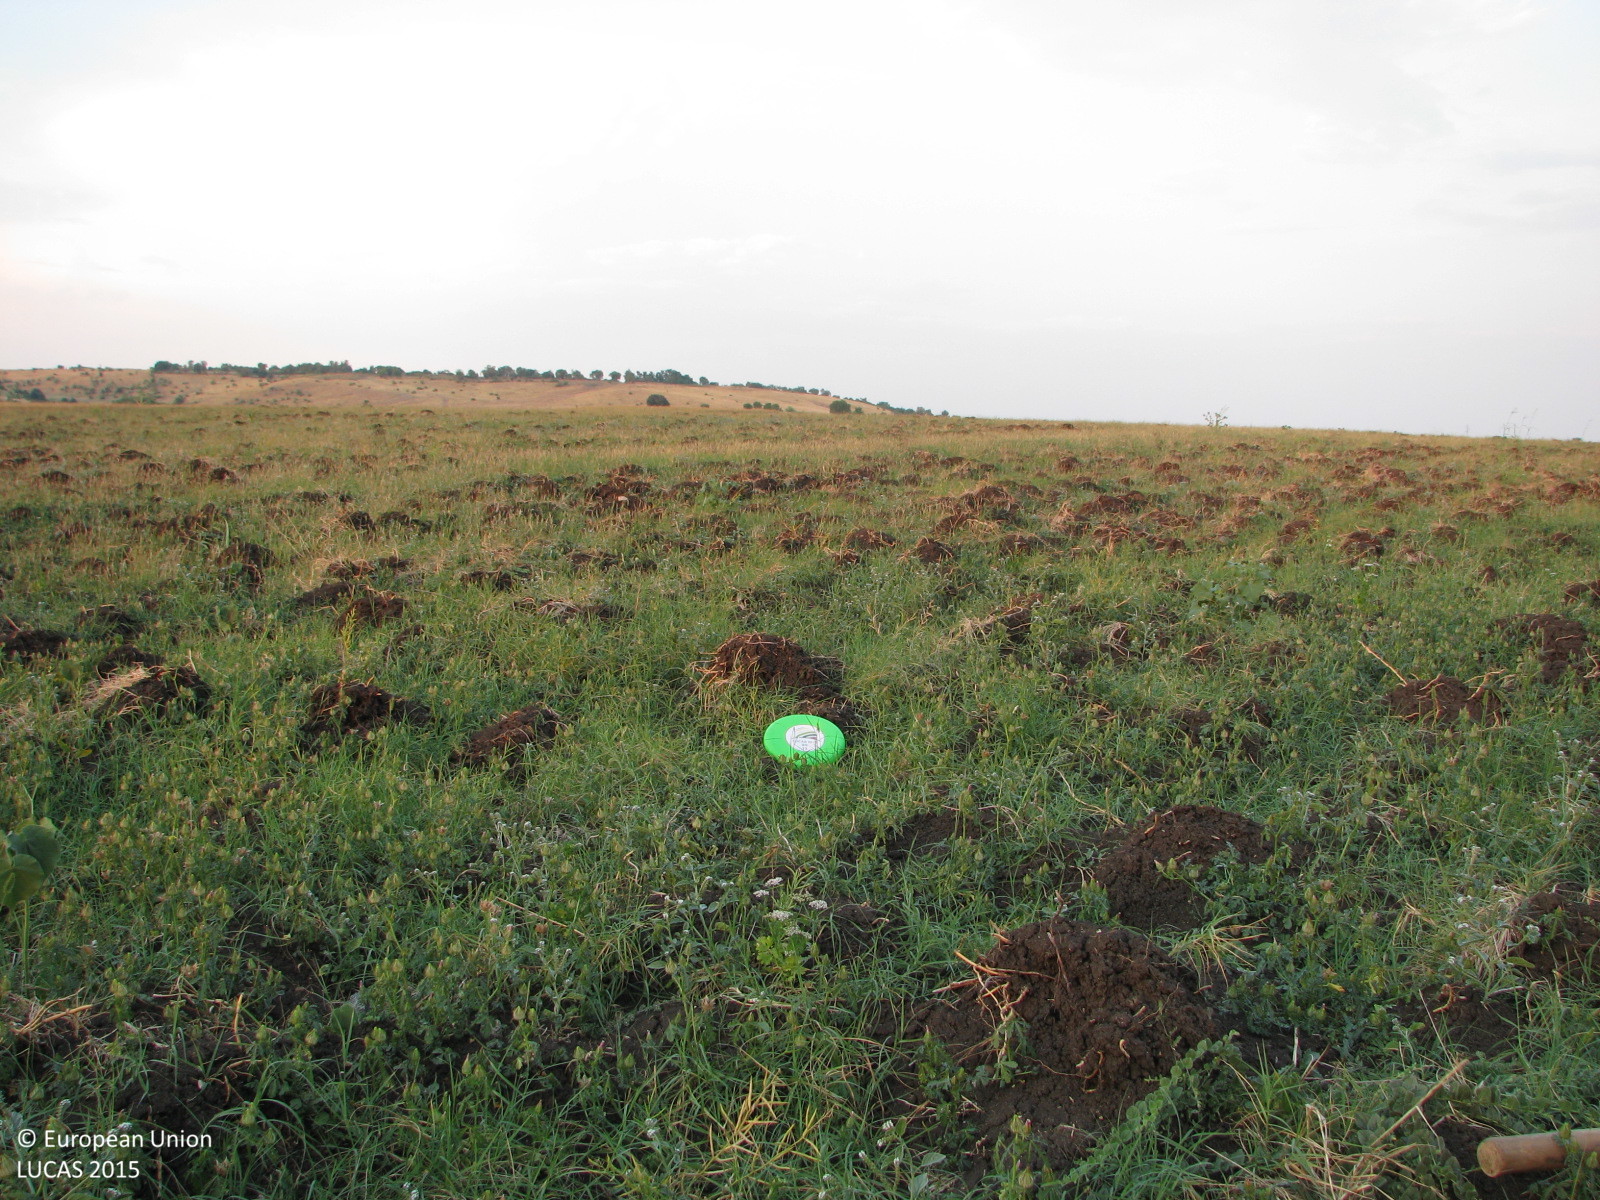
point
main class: Grassland
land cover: Spontaneously vegetated surfaces
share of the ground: > 75 %
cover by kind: herbaceous plants 90 %, unconsolidated bare surface 10 %
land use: Agriculture (excluding fallow land and kitchen gardens)
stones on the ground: < 10 %
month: August
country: BG
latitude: 42.1899
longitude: 26.3965
